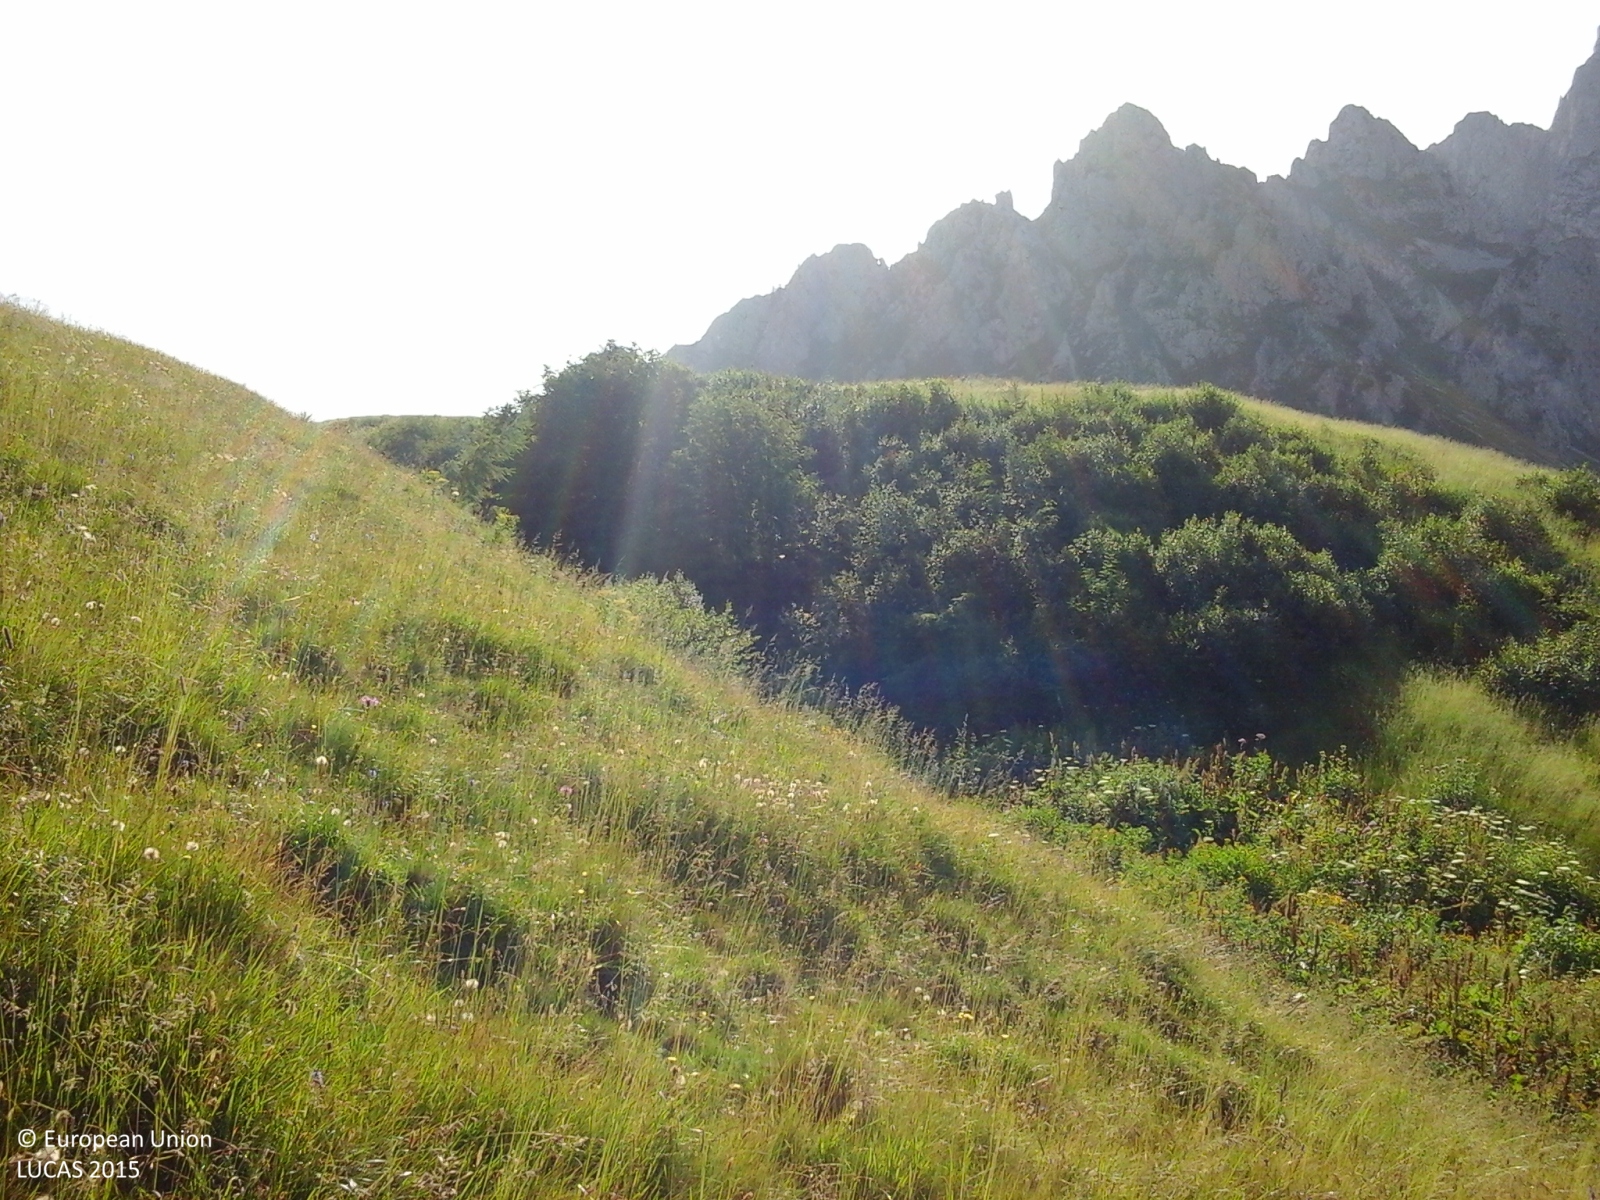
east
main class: Grassland
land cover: Grassland without tree/shrub cover
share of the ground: > 75 %
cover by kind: herbaceous plants 100 %
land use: Agriculture (excluding fallow land and kitchen gardens)
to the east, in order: Grassland without tree/shrub cover; Broadleaved woodland; Grassland without tree/shrub cover
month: July
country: IT
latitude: 46.0267
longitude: 10.2451
